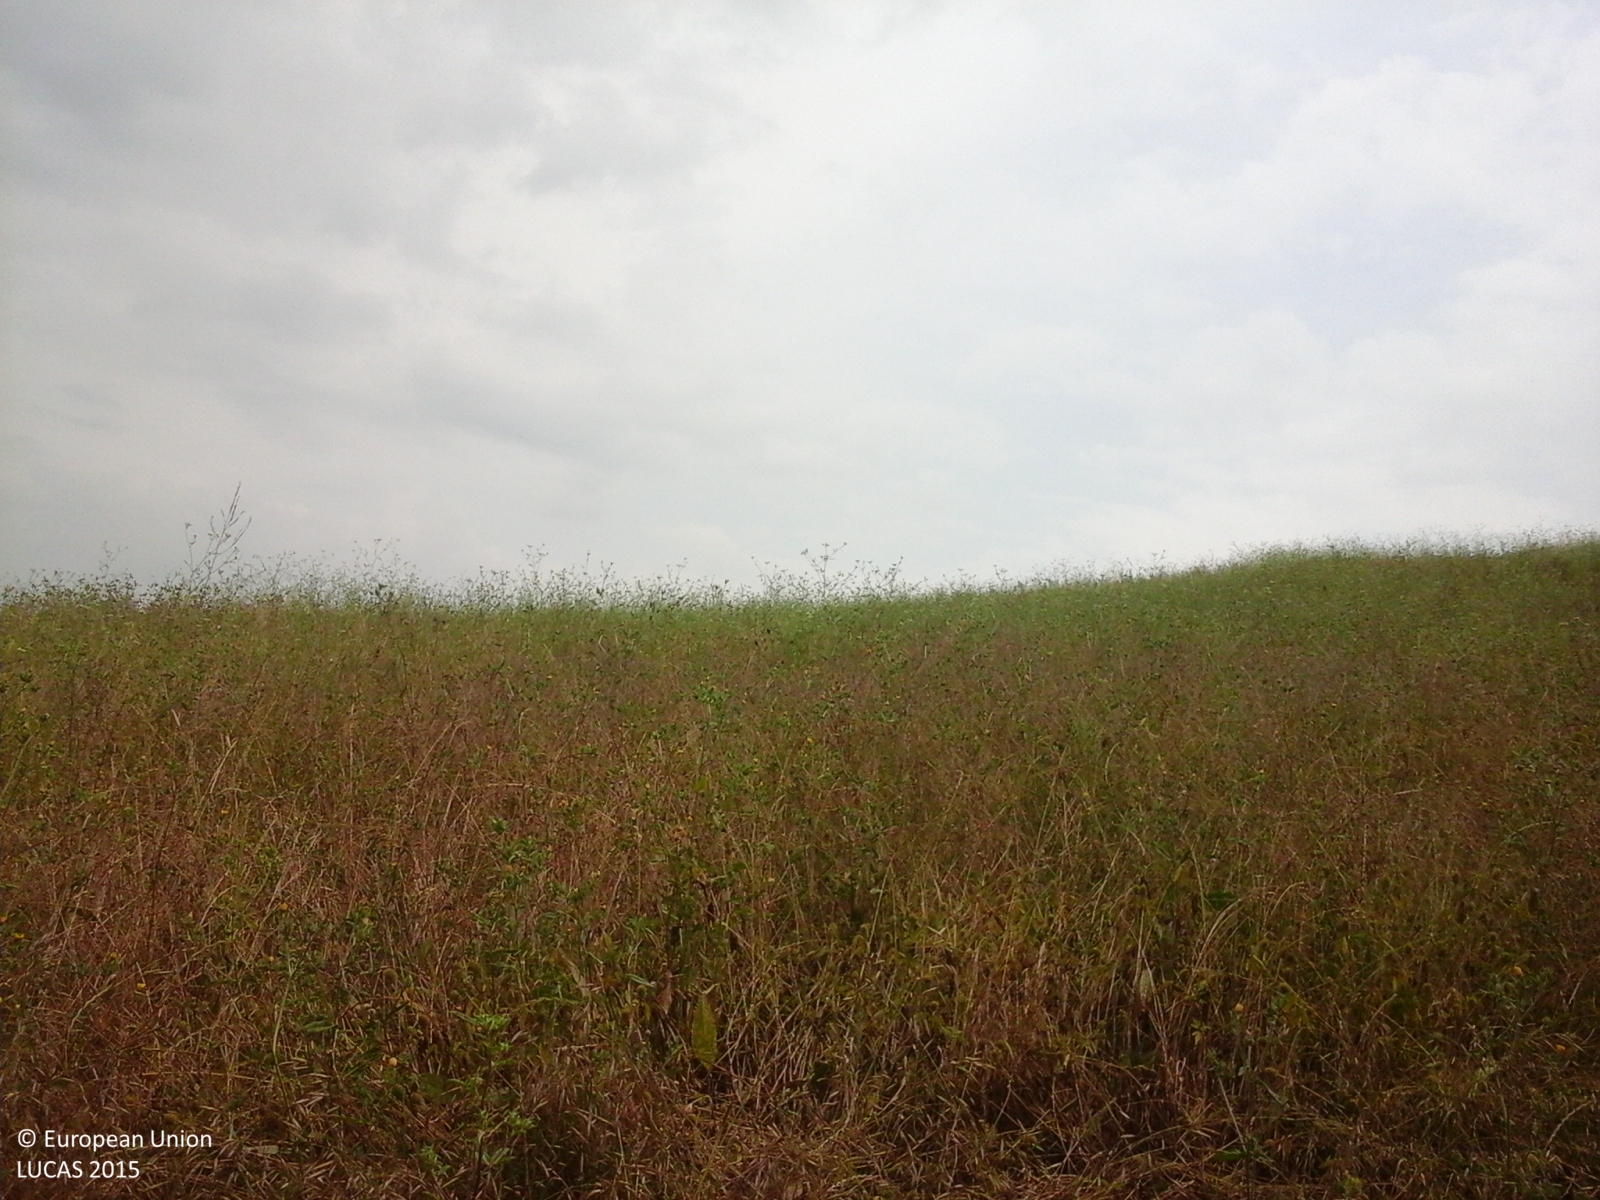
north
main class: Cropland
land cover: Temporary grasslands
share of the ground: > 75 %
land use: Agriculture (excluding fallow land and kitchen gardens)
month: August
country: IT
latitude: 43.6606
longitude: 10.9522
